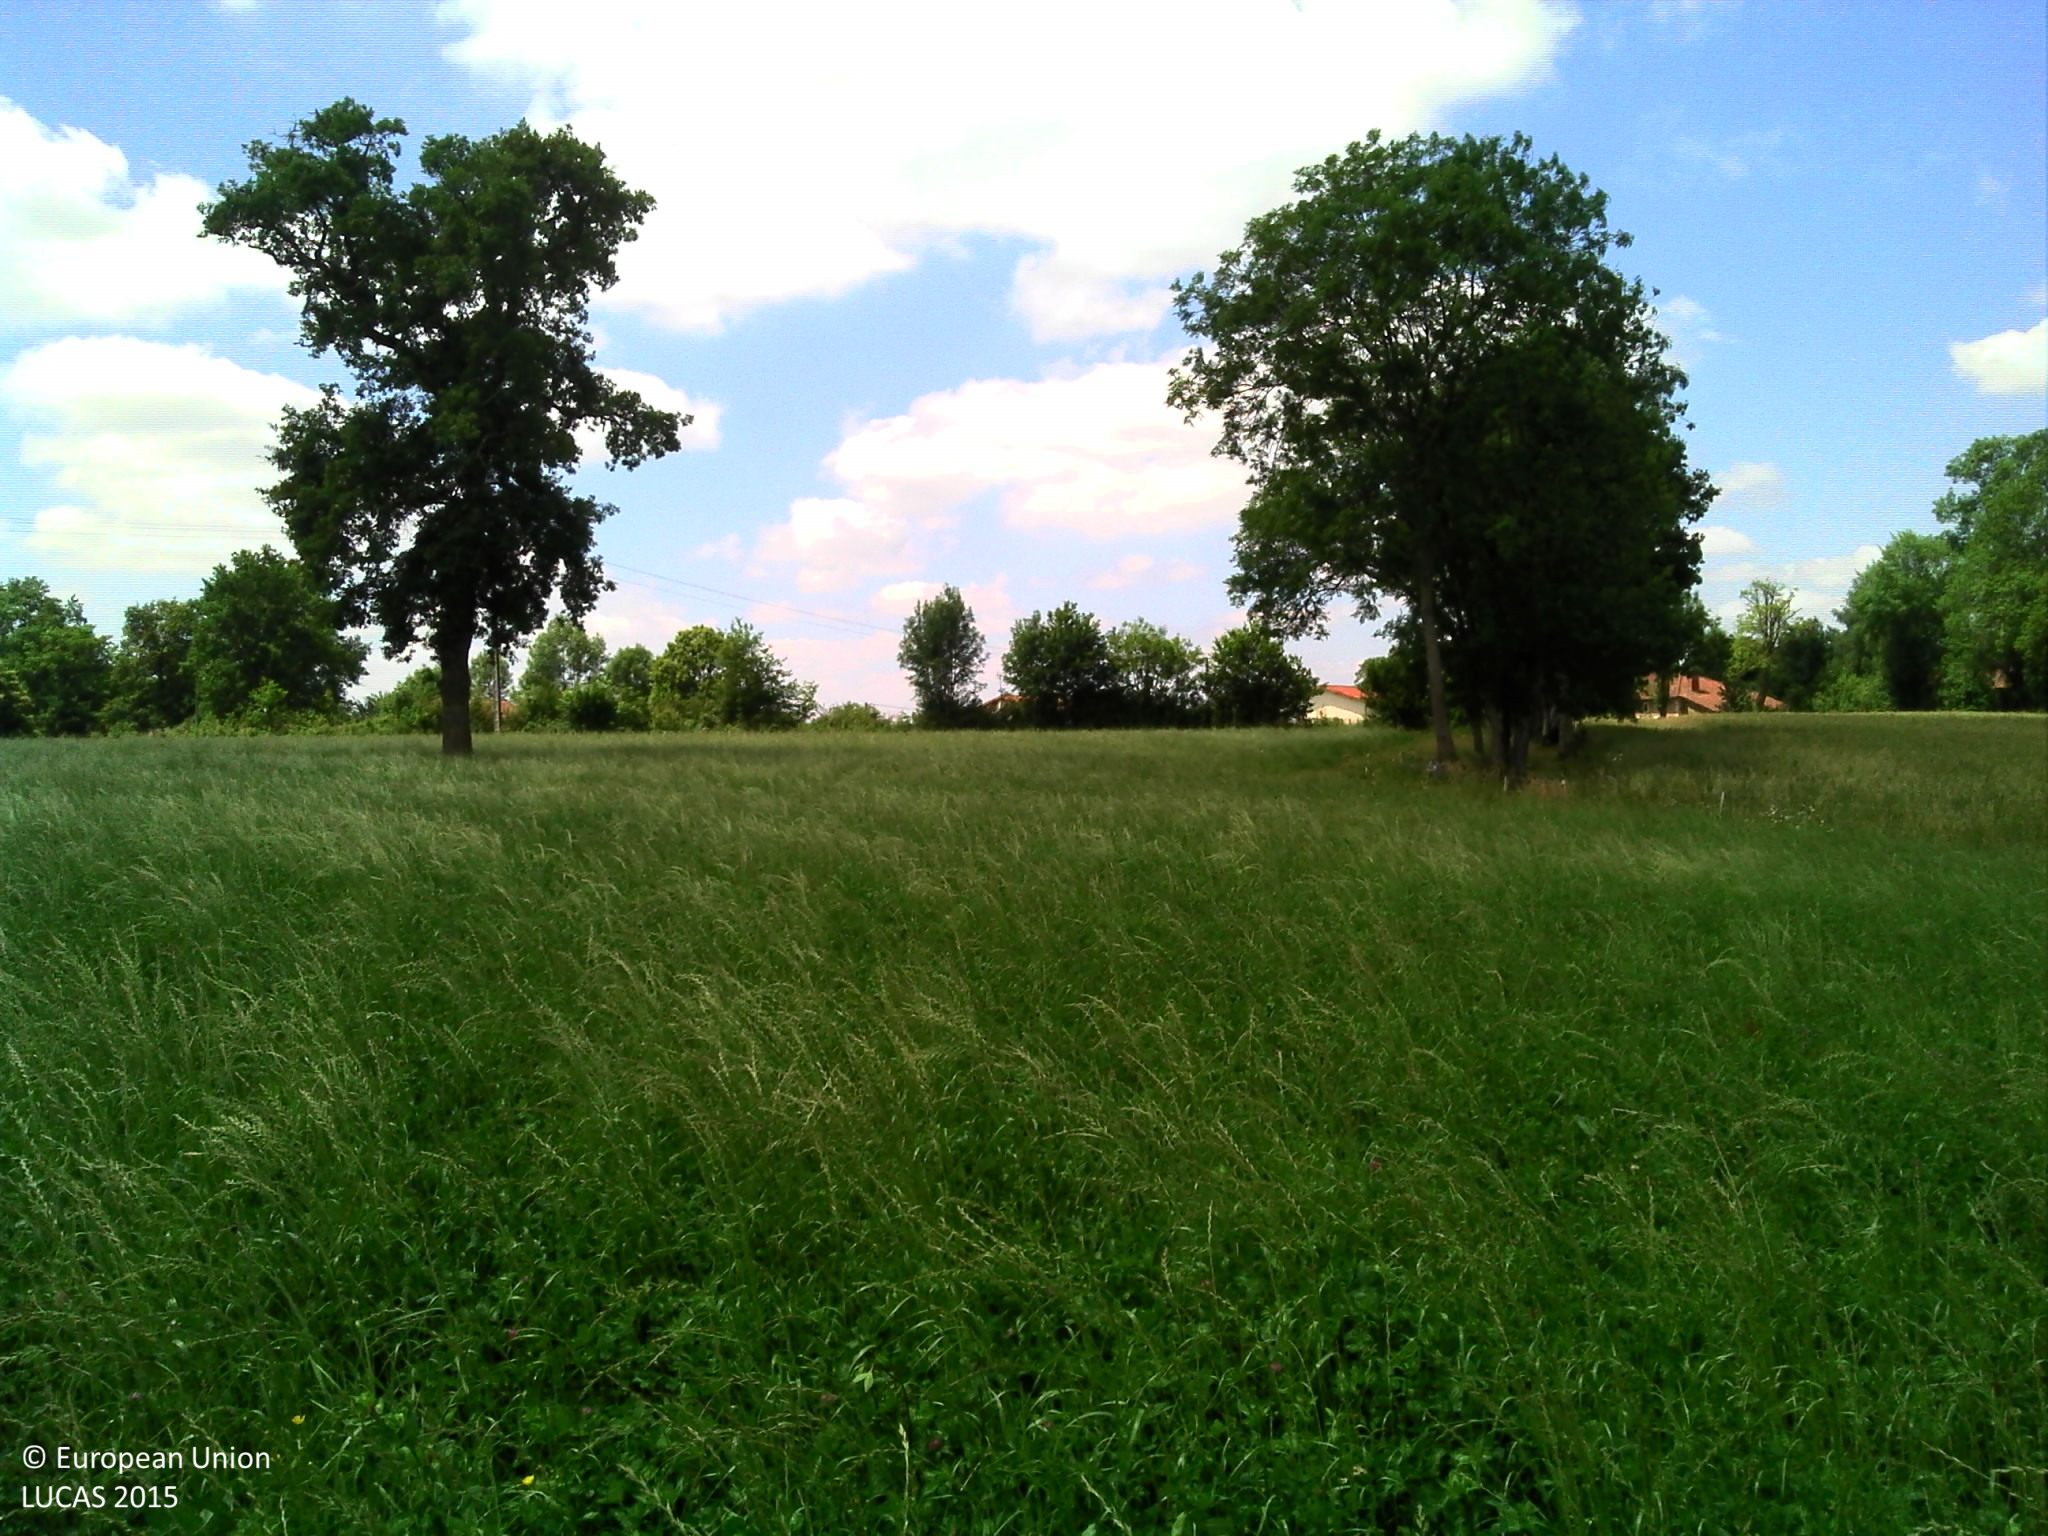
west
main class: Cropland
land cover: Temporary grasslands
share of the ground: > 75 %
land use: Agriculture (excluding fallow land and kitchen gardens)
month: June
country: FR
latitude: 45.9775
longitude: 0.6541
